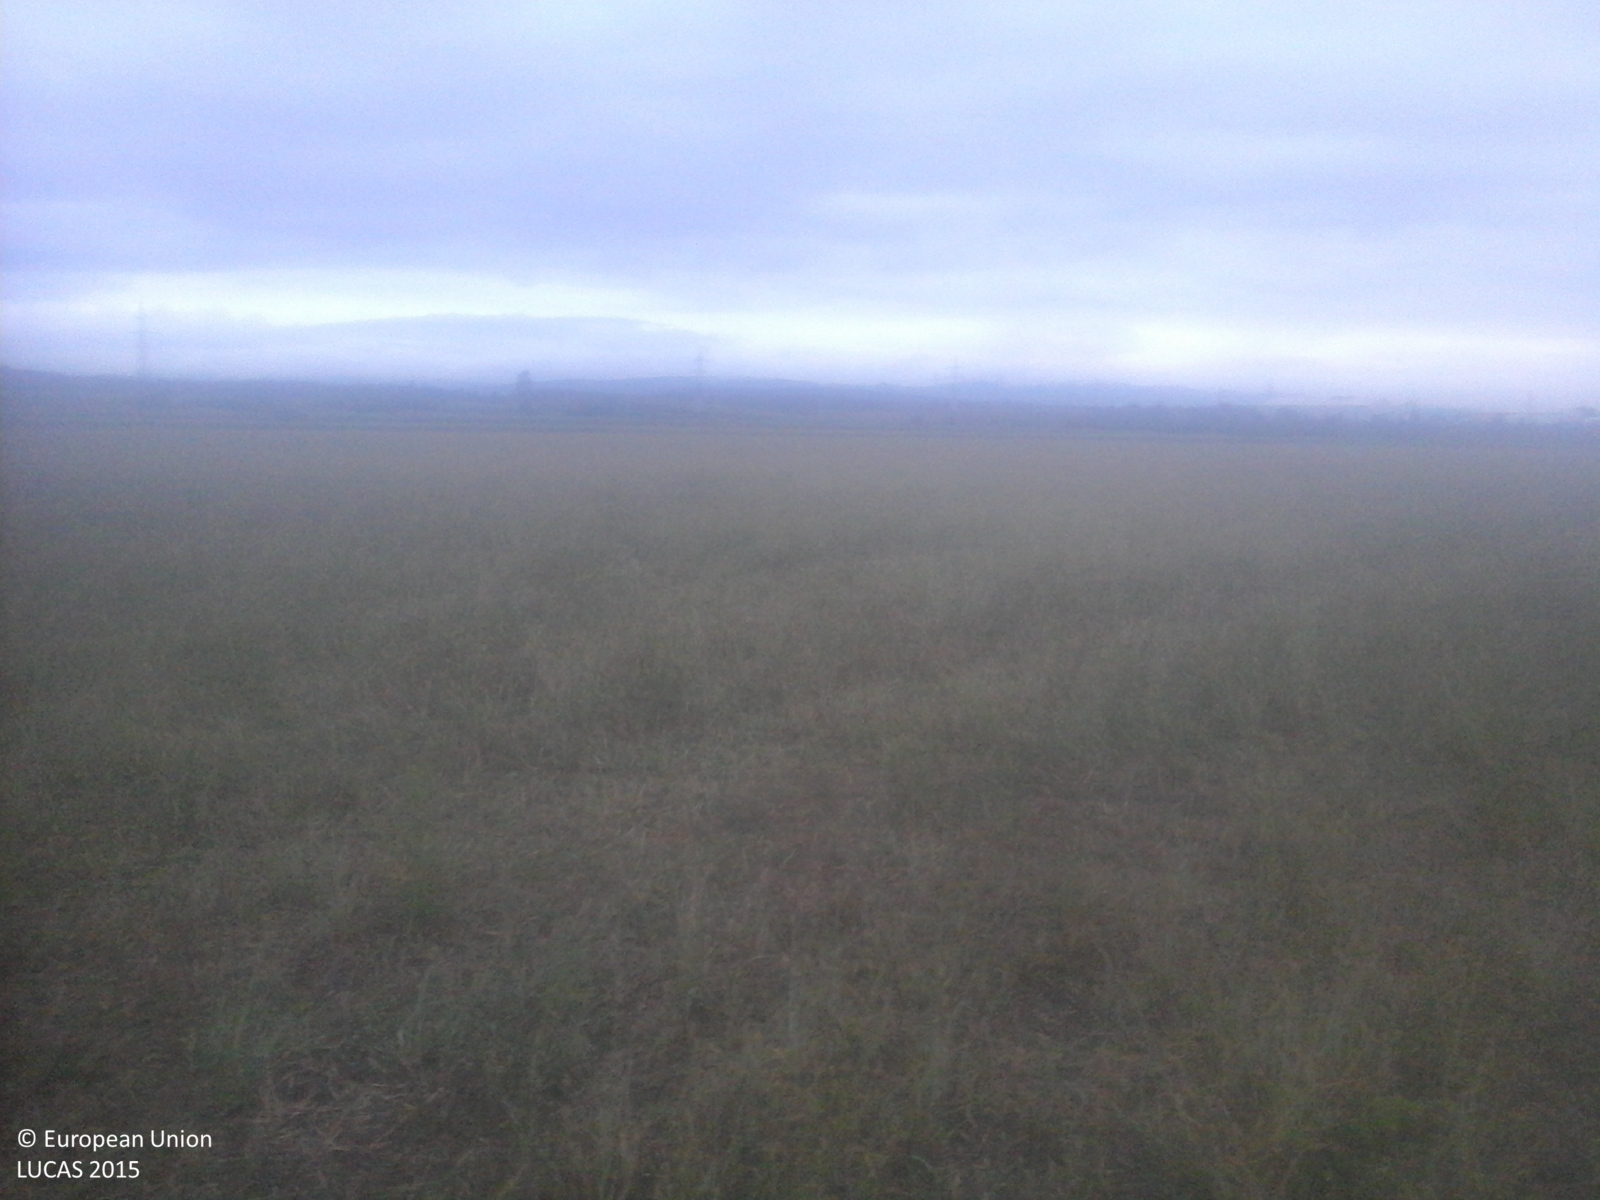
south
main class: Grassland
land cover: Spontaneously vegetated surfaces
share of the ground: > 75 %
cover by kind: herbaceous plants 100 %
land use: Fallow land
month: September
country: RO
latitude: 46.0185
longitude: 23.5111
